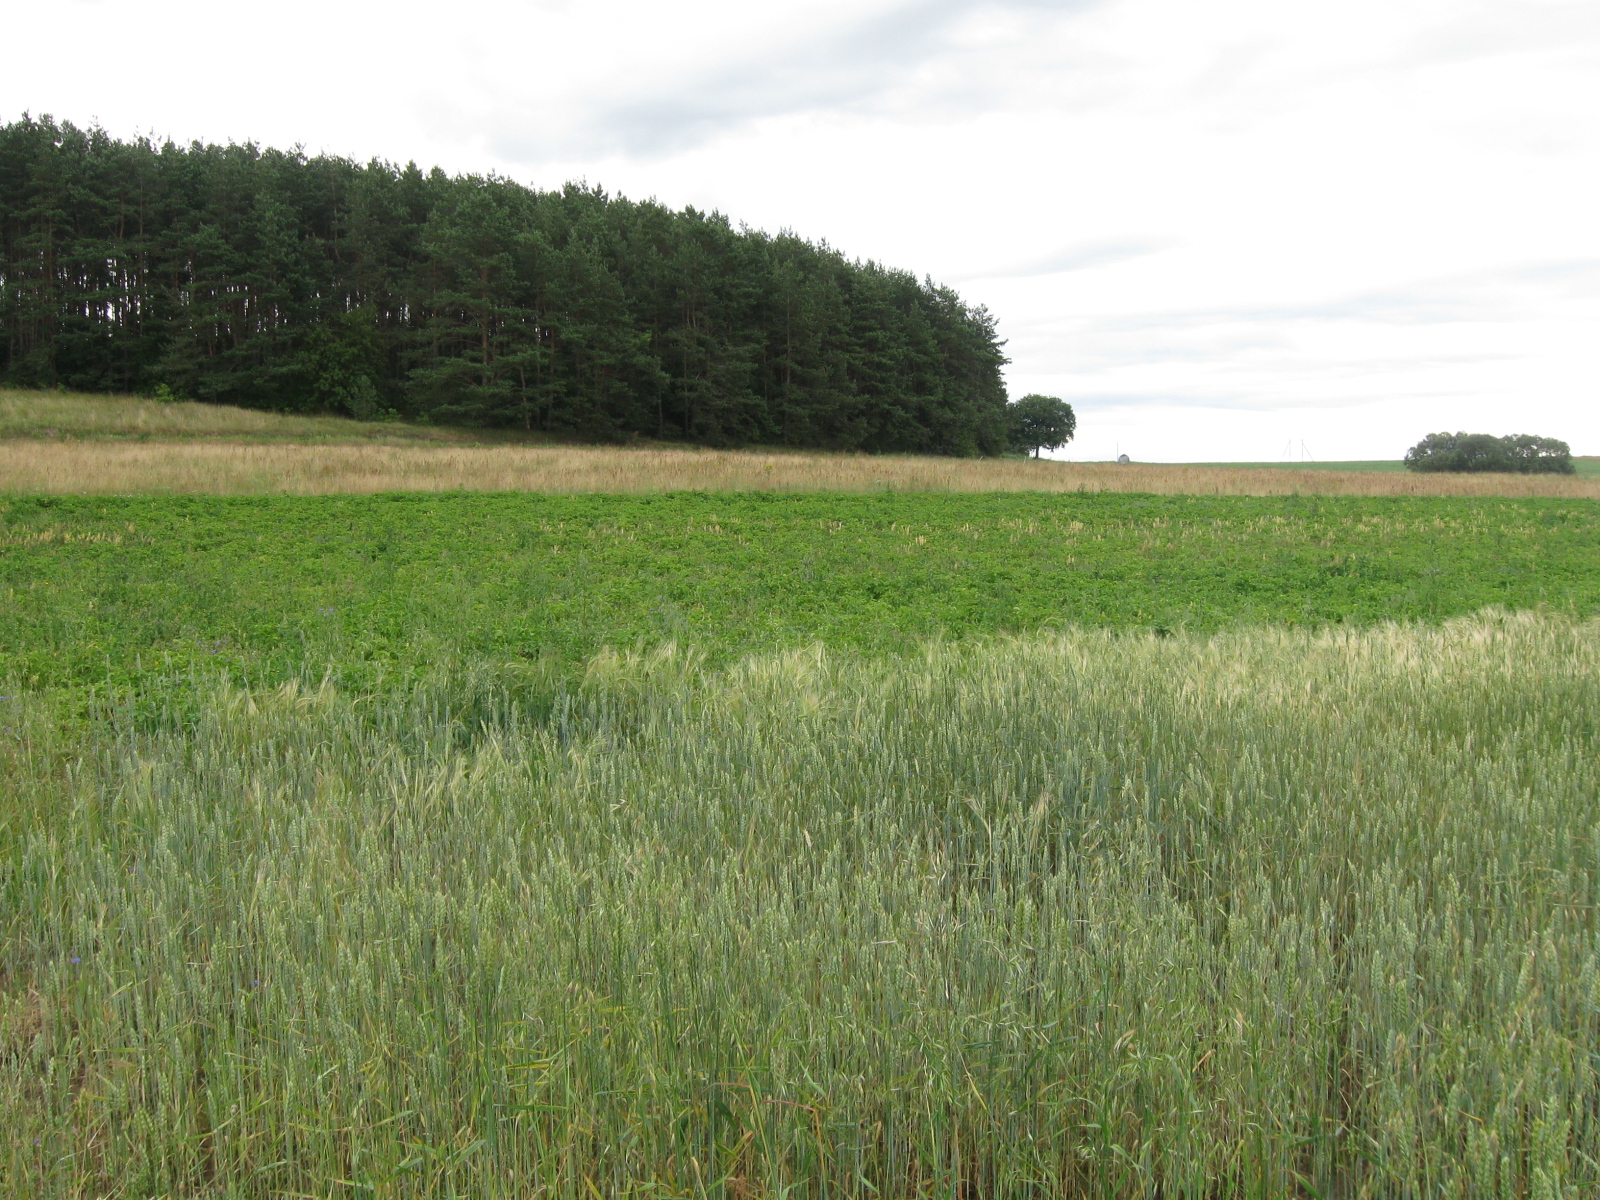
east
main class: Grassland
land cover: Grassland without tree/shrub cover
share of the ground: > 75 %
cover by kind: herbaceous plants 90 %, unconsolidated bare surface 10 %
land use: Agriculture (excluding fallow land and kitchen gardens)
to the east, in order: Electric lines; Common wheat; Potatoes; Sugar beet; Grassland without tree/shrub cover; Tracks; Grassland without tree/shrub cover; Tracks; Pine dominated coniferous woodland; Electric lines; Grassland without tree/shrub cover
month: July
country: LT
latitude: 55.0128
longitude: 23.6734
